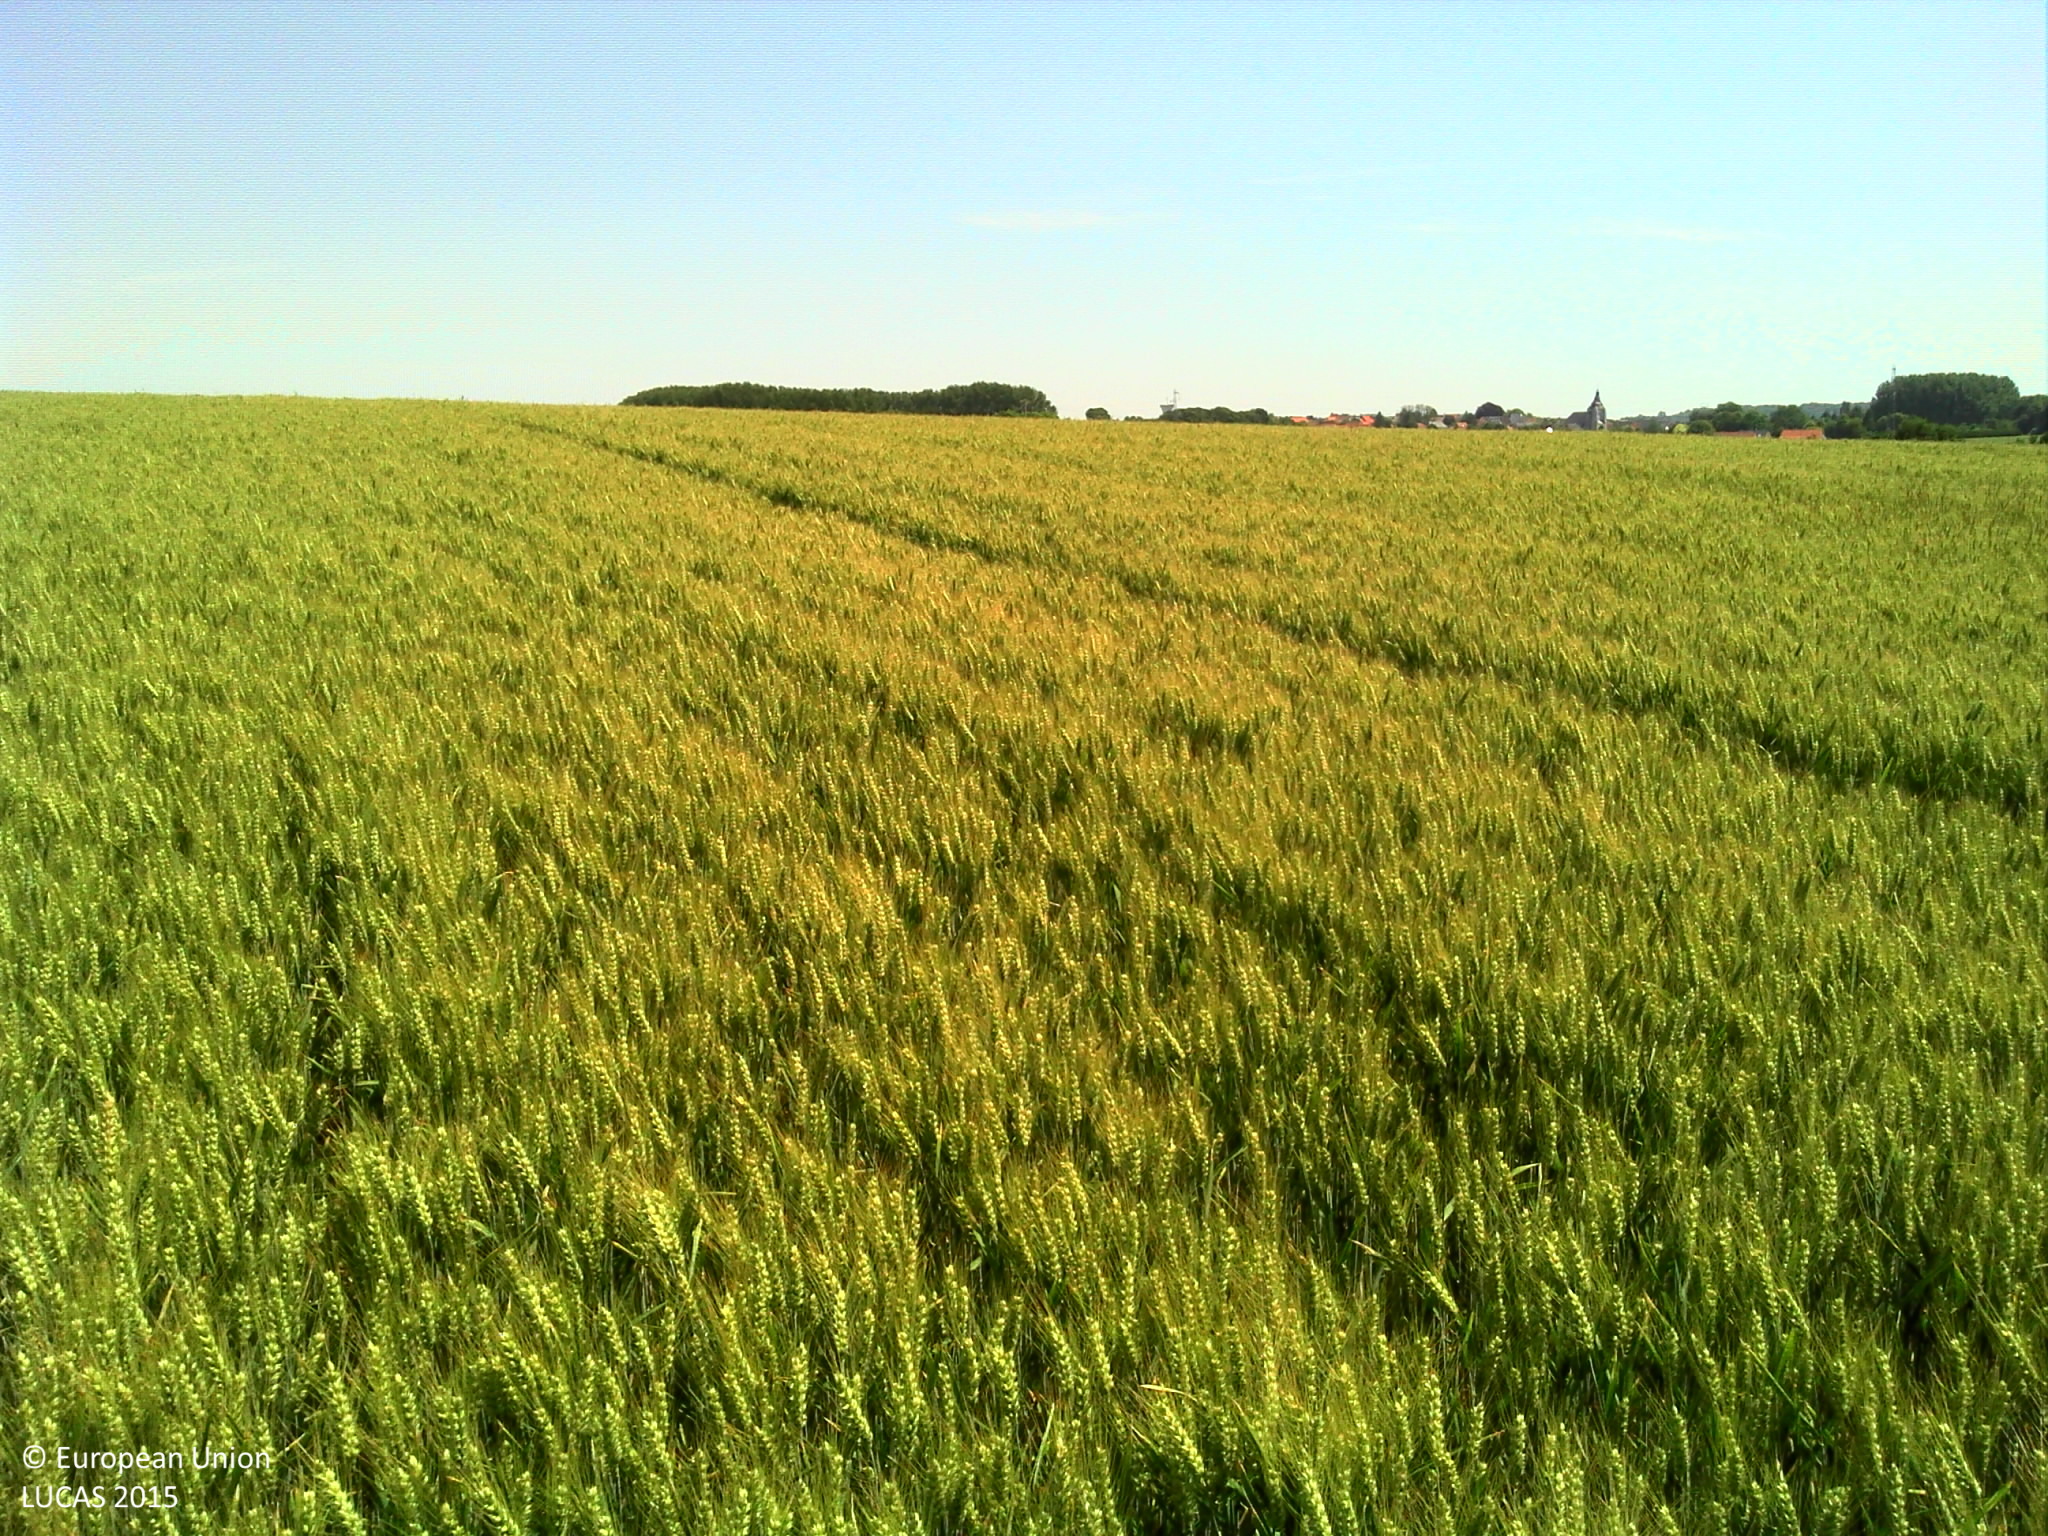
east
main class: Cropland
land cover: Common wheat
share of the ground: > 75 %
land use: Agriculture (excluding fallow land and kitchen gardens)
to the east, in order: Common wheat; Sugar beet
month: July
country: FR
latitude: 50.2807
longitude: 2.5078
